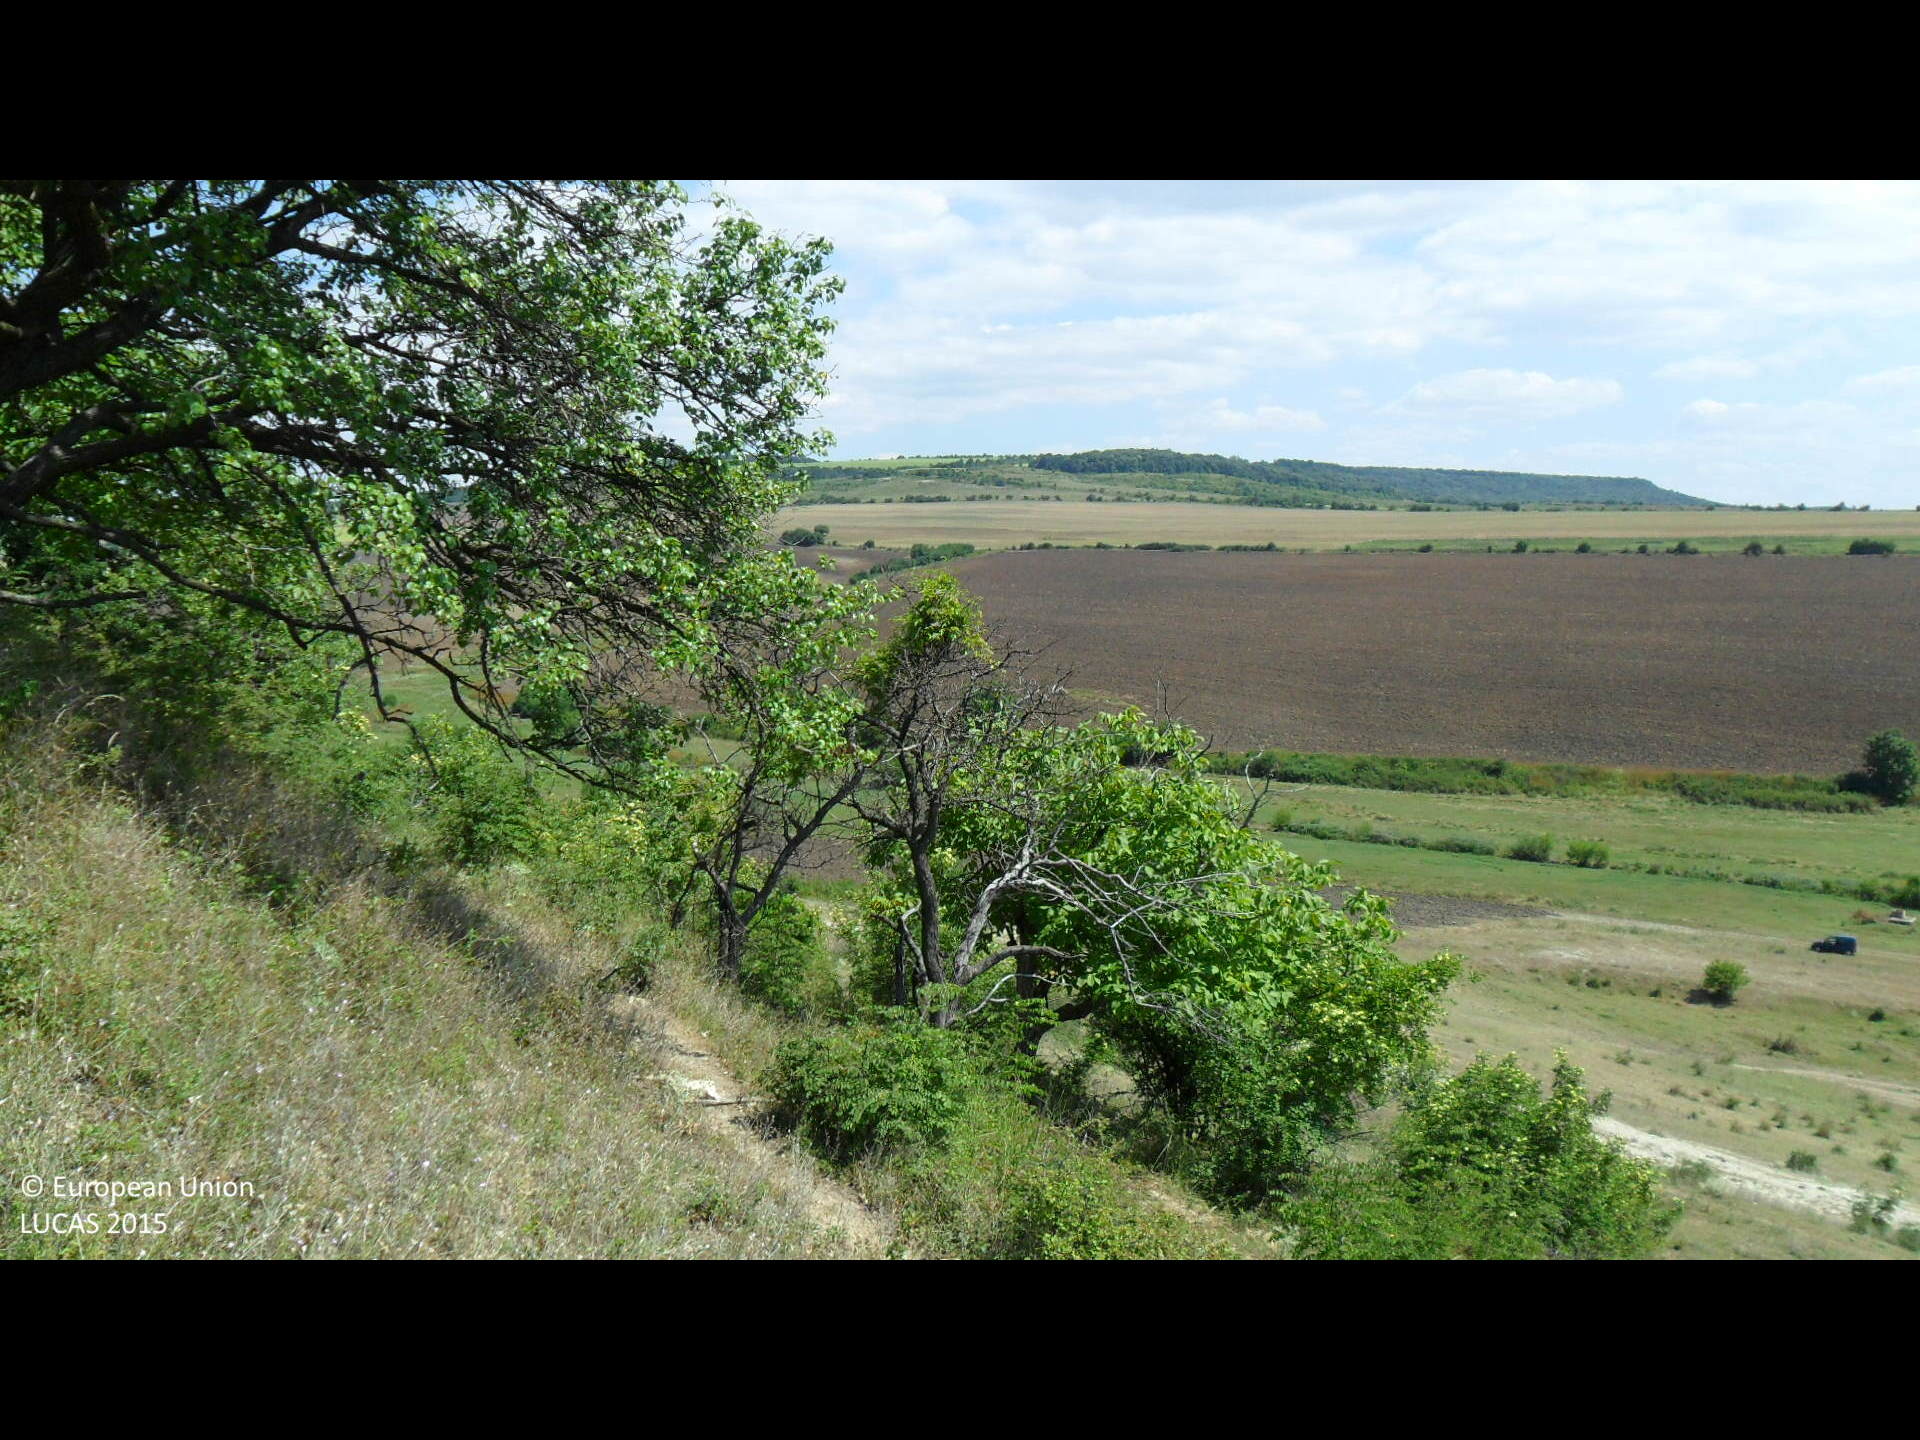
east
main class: Grassland
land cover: Grassland with sparse tree/shrub cover
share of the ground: > 75 %
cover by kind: herbaceous plants 90 %, broadleaved forest trees 5 %, shrubs 5 %
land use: Agriculture (excluding fallow land and kitchen gardens)
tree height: < 5 m
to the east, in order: Grassland with sparse tree/shrub cover; Shrubland with sparse tree cover; Grassland with sparse tree/shrub cover; Other bare soil; Grassland with sparse tree/shrub cover; Tracks; Common wheat
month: August
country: BG
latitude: 43.4357
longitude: 26.4221
